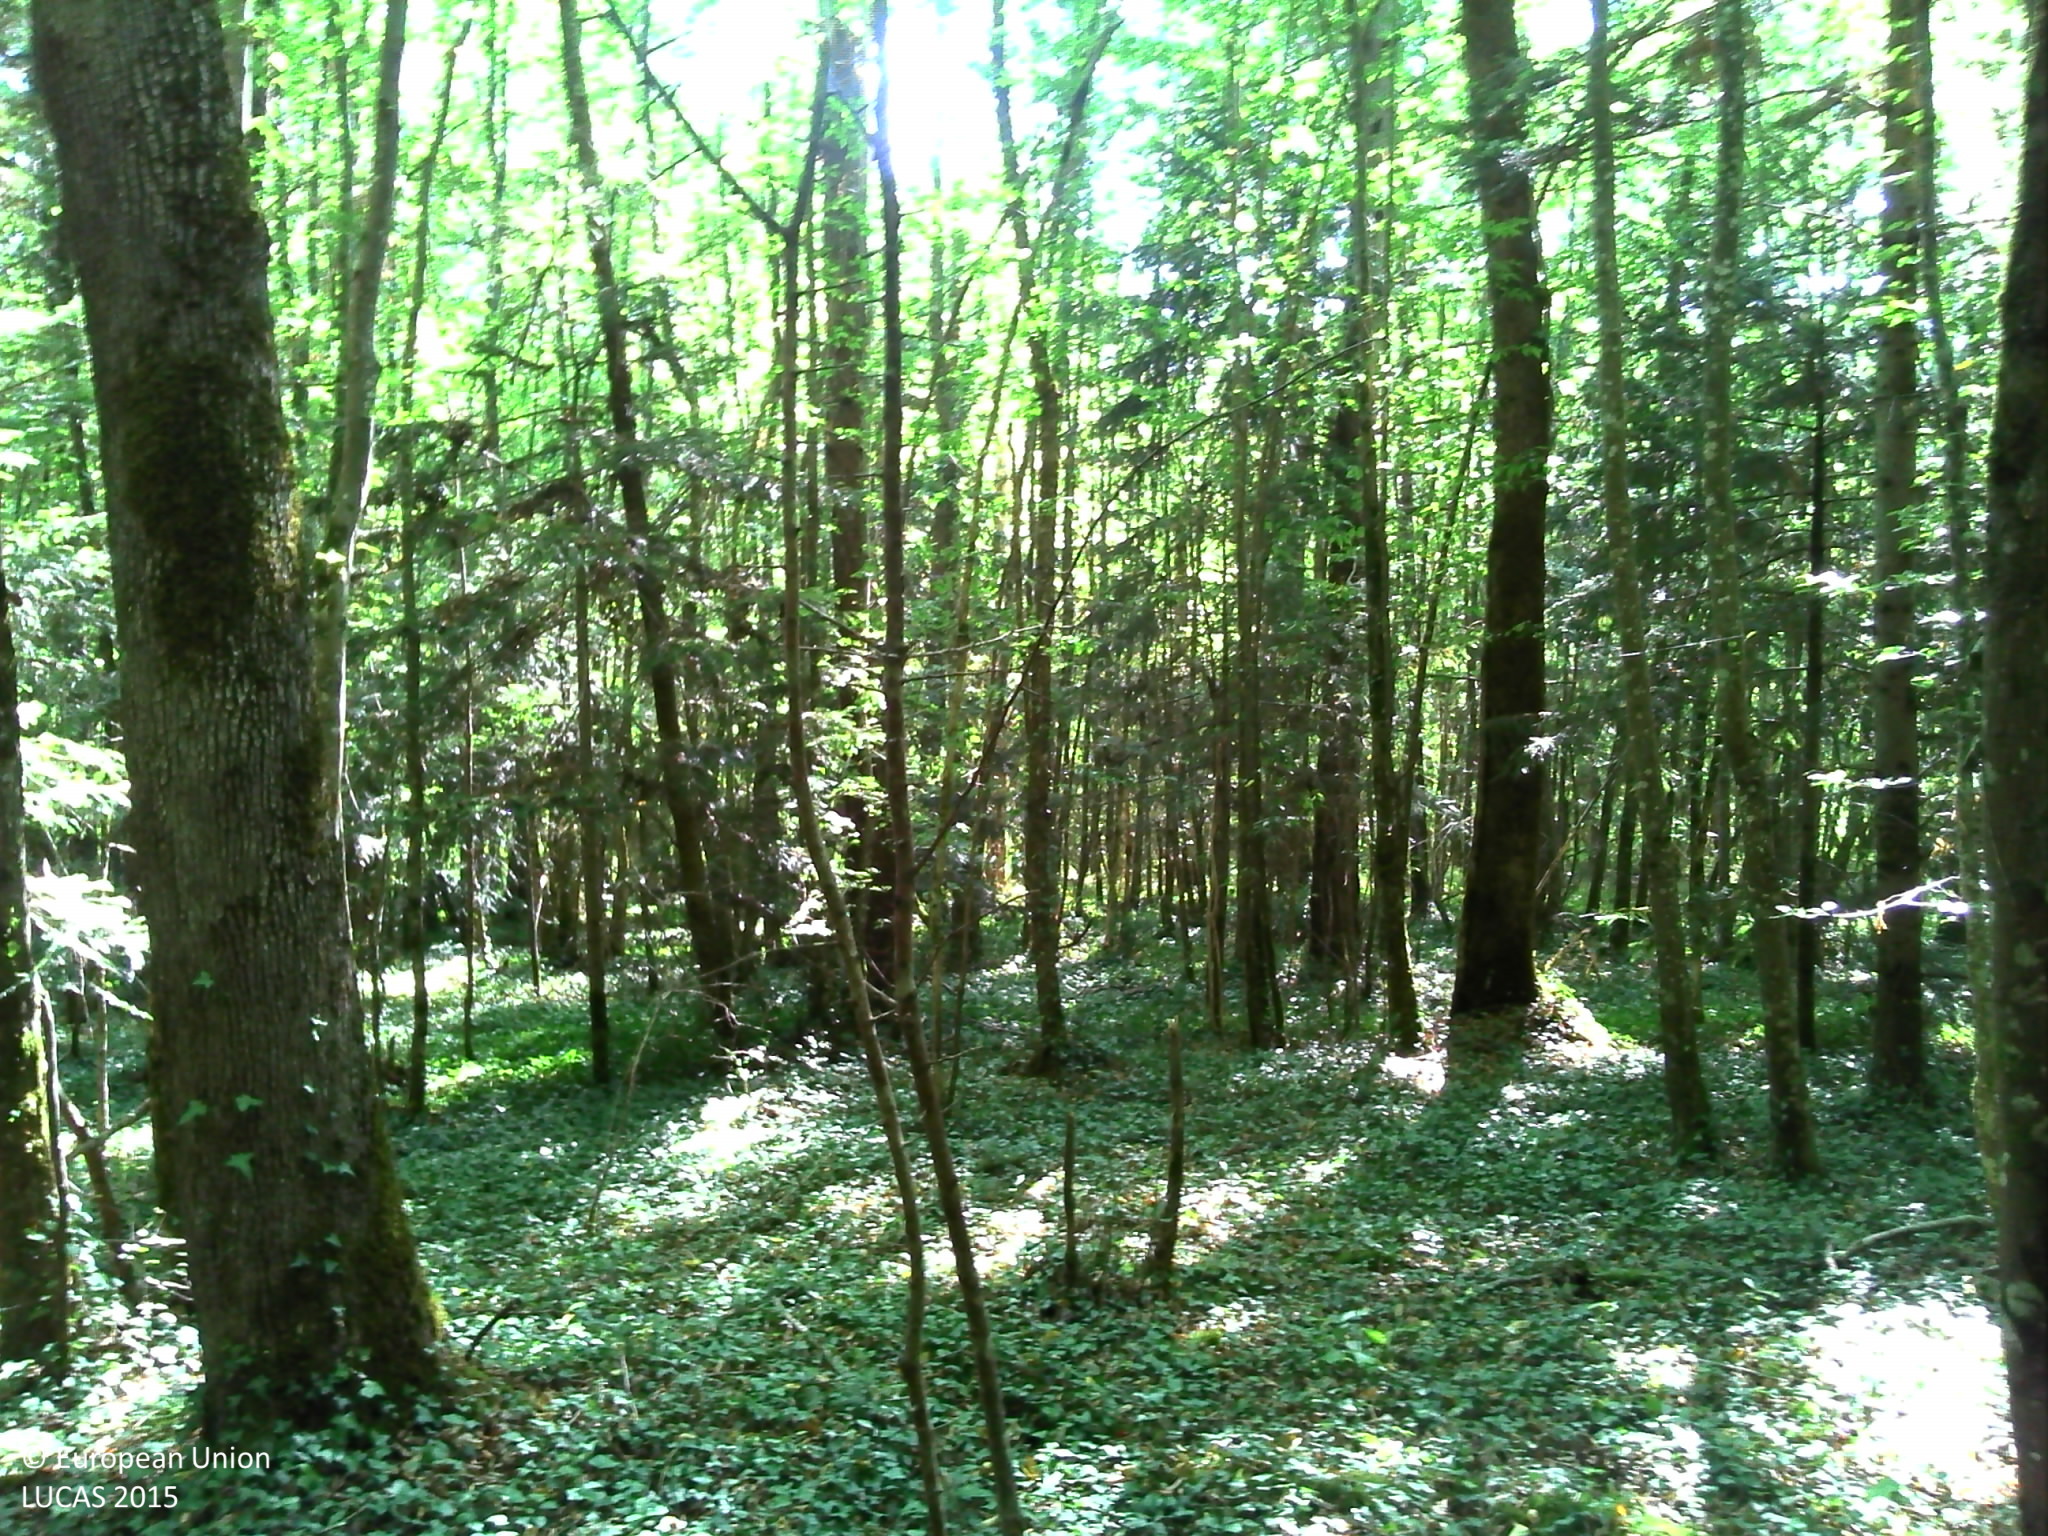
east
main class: Woodland
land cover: Pine dominated coniferous woodland
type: hemiboreal forest and nemoral coniferous forest and mixed broadleaved-coniferous forest
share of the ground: > 75 %
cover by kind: coniferous forest trees 80 %, herbaceous plants 10 %, shrubs 5 %, lichens and mosses 5 %
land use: Forestry
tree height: > 5 m
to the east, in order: Pine dominated coniferous woodland; Tracks; Fences; Abandoned hedges; Fences; Grass margins; Paved roads, cycling and walking lanes; Grass margins; Ditches and canals; Managed hedges; Fences; Grass margins; Inland fresh running water; Grass margins; Abandoned hedges; Electric lines; Broadleaved woodland; Grassland without tree/shrub cover
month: August
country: FR
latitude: 44.7716
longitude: 0.7557
